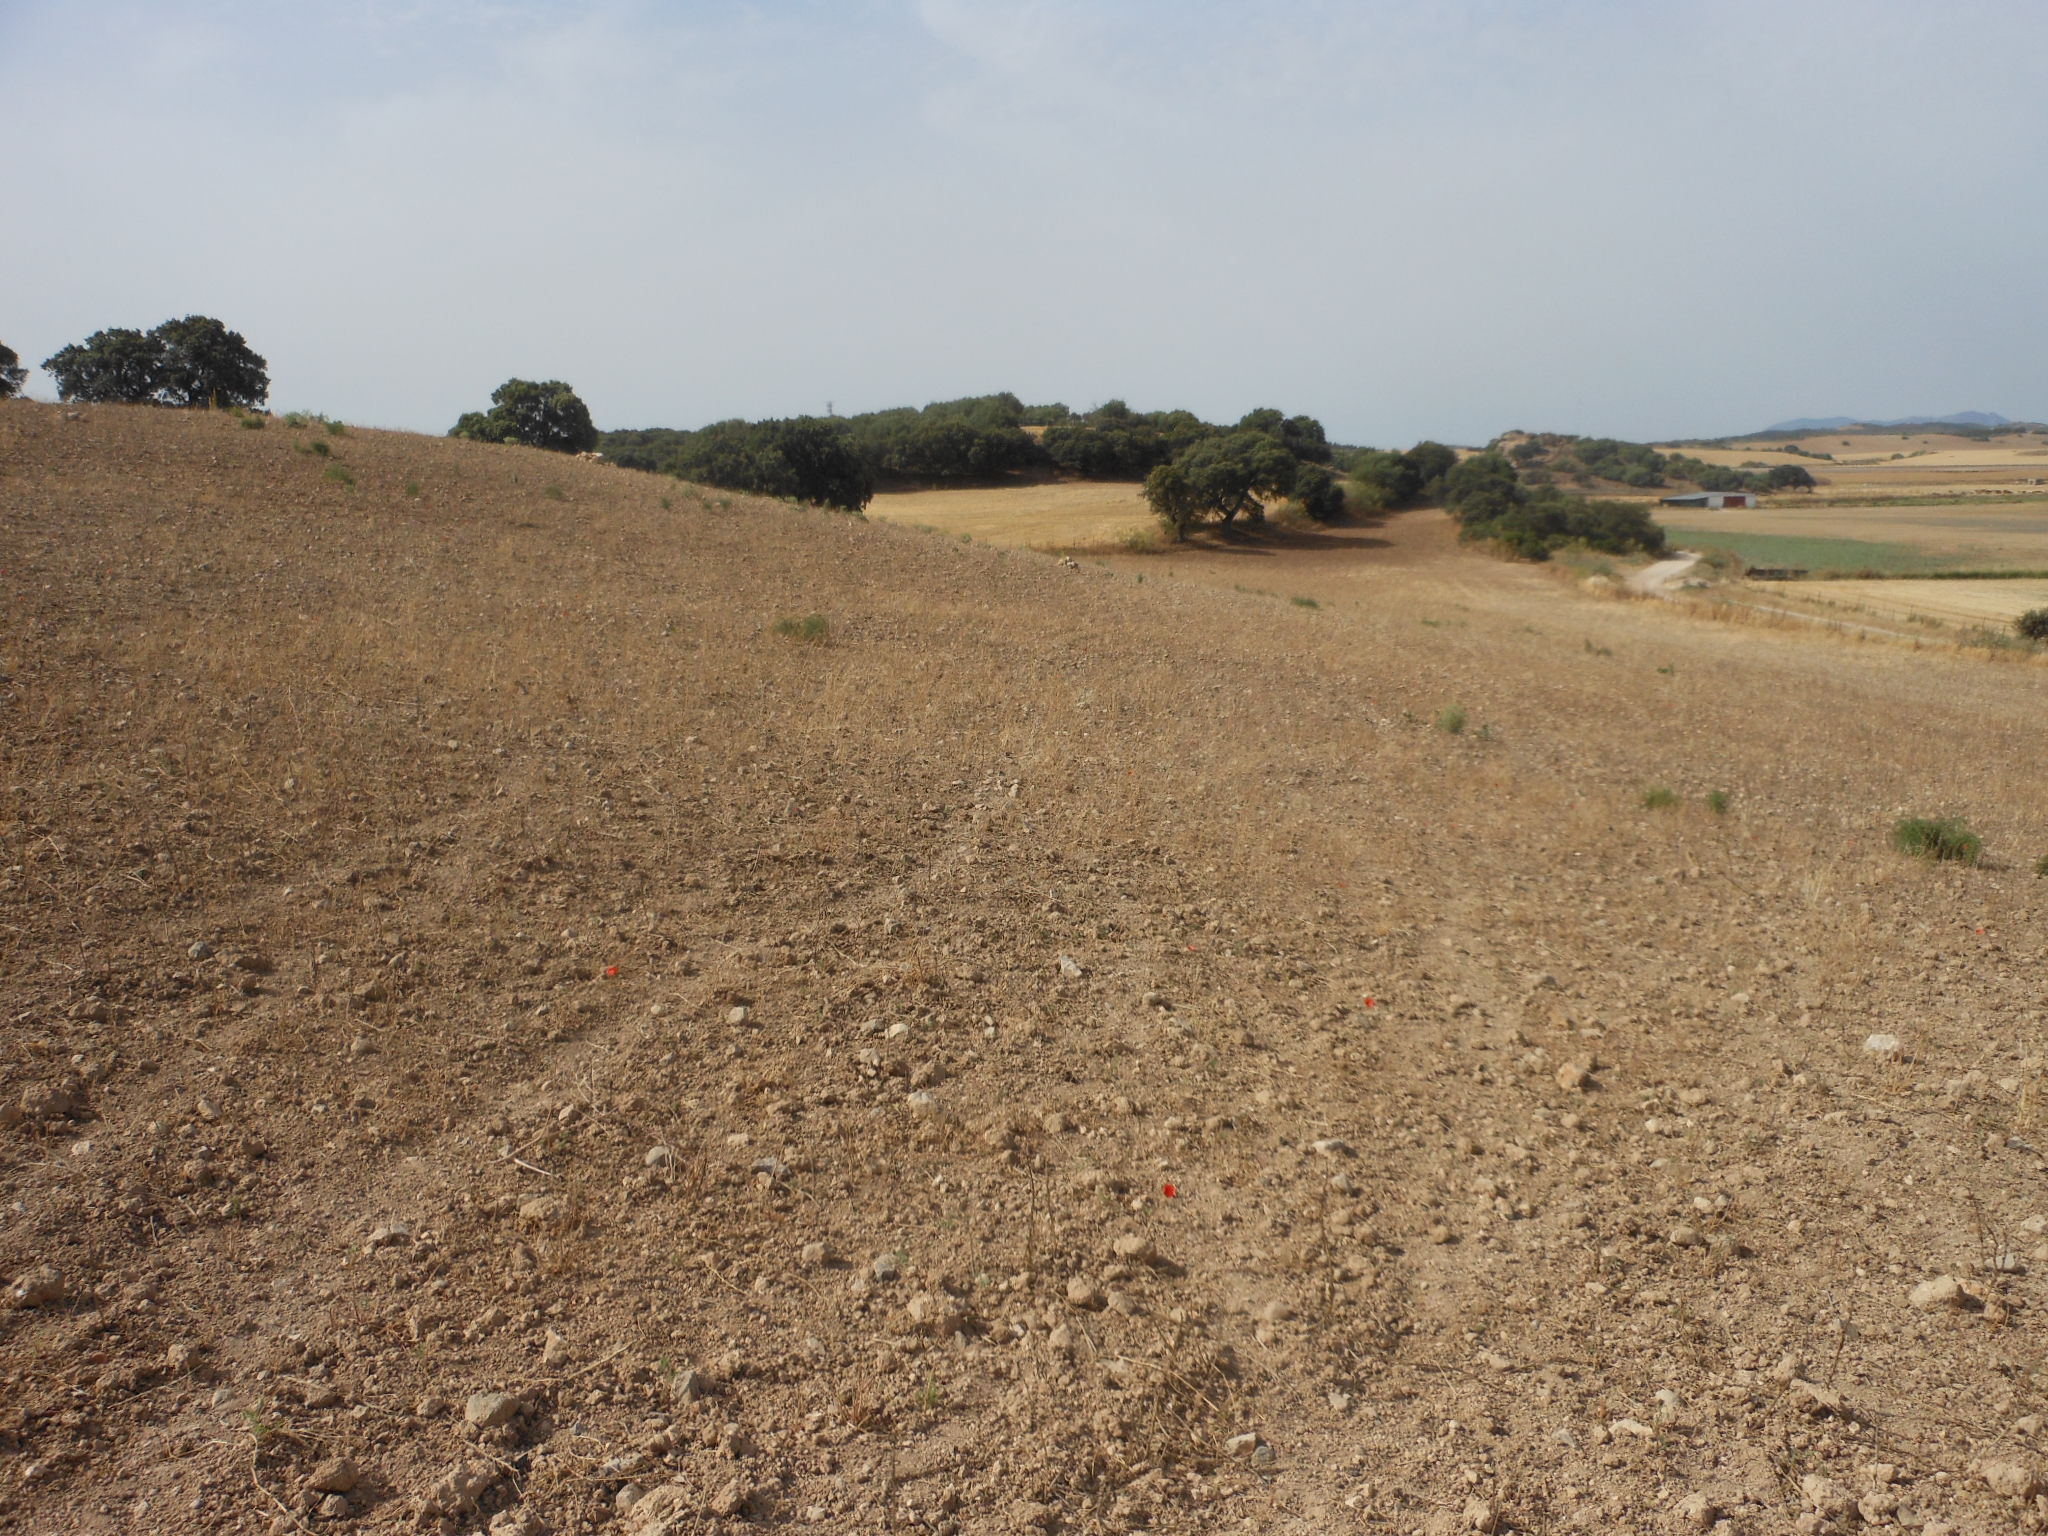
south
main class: Cropland
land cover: Dry pulses
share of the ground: < 10 %
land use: Agriculture (excluding fallow land and kitchen gardens)
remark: Harvested field
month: June
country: ES
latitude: 37.1698
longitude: -5.0404
